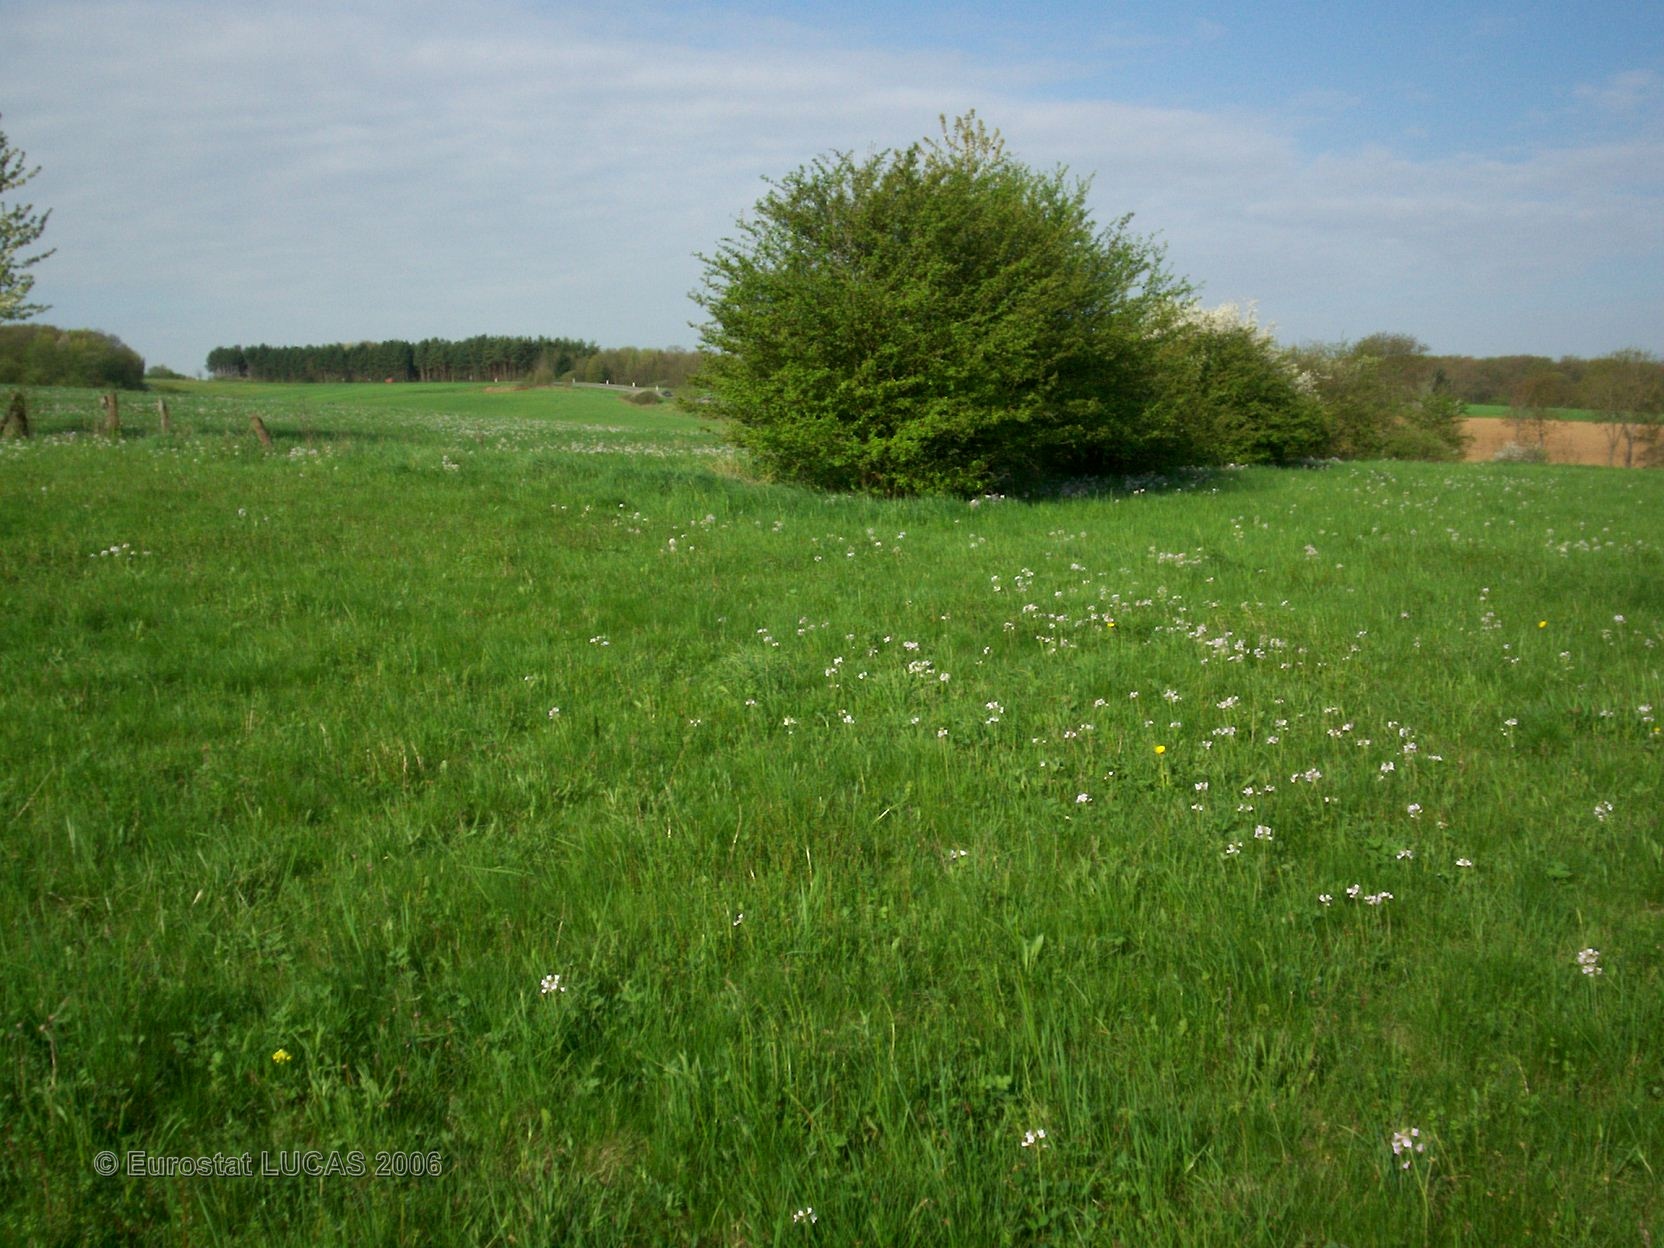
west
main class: Grassland
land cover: Grassland without tree/shrub cover
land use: Agriculture (excluding fallow land and kitchen gardens)
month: April
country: FR
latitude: 49.0448
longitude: 6.9221
